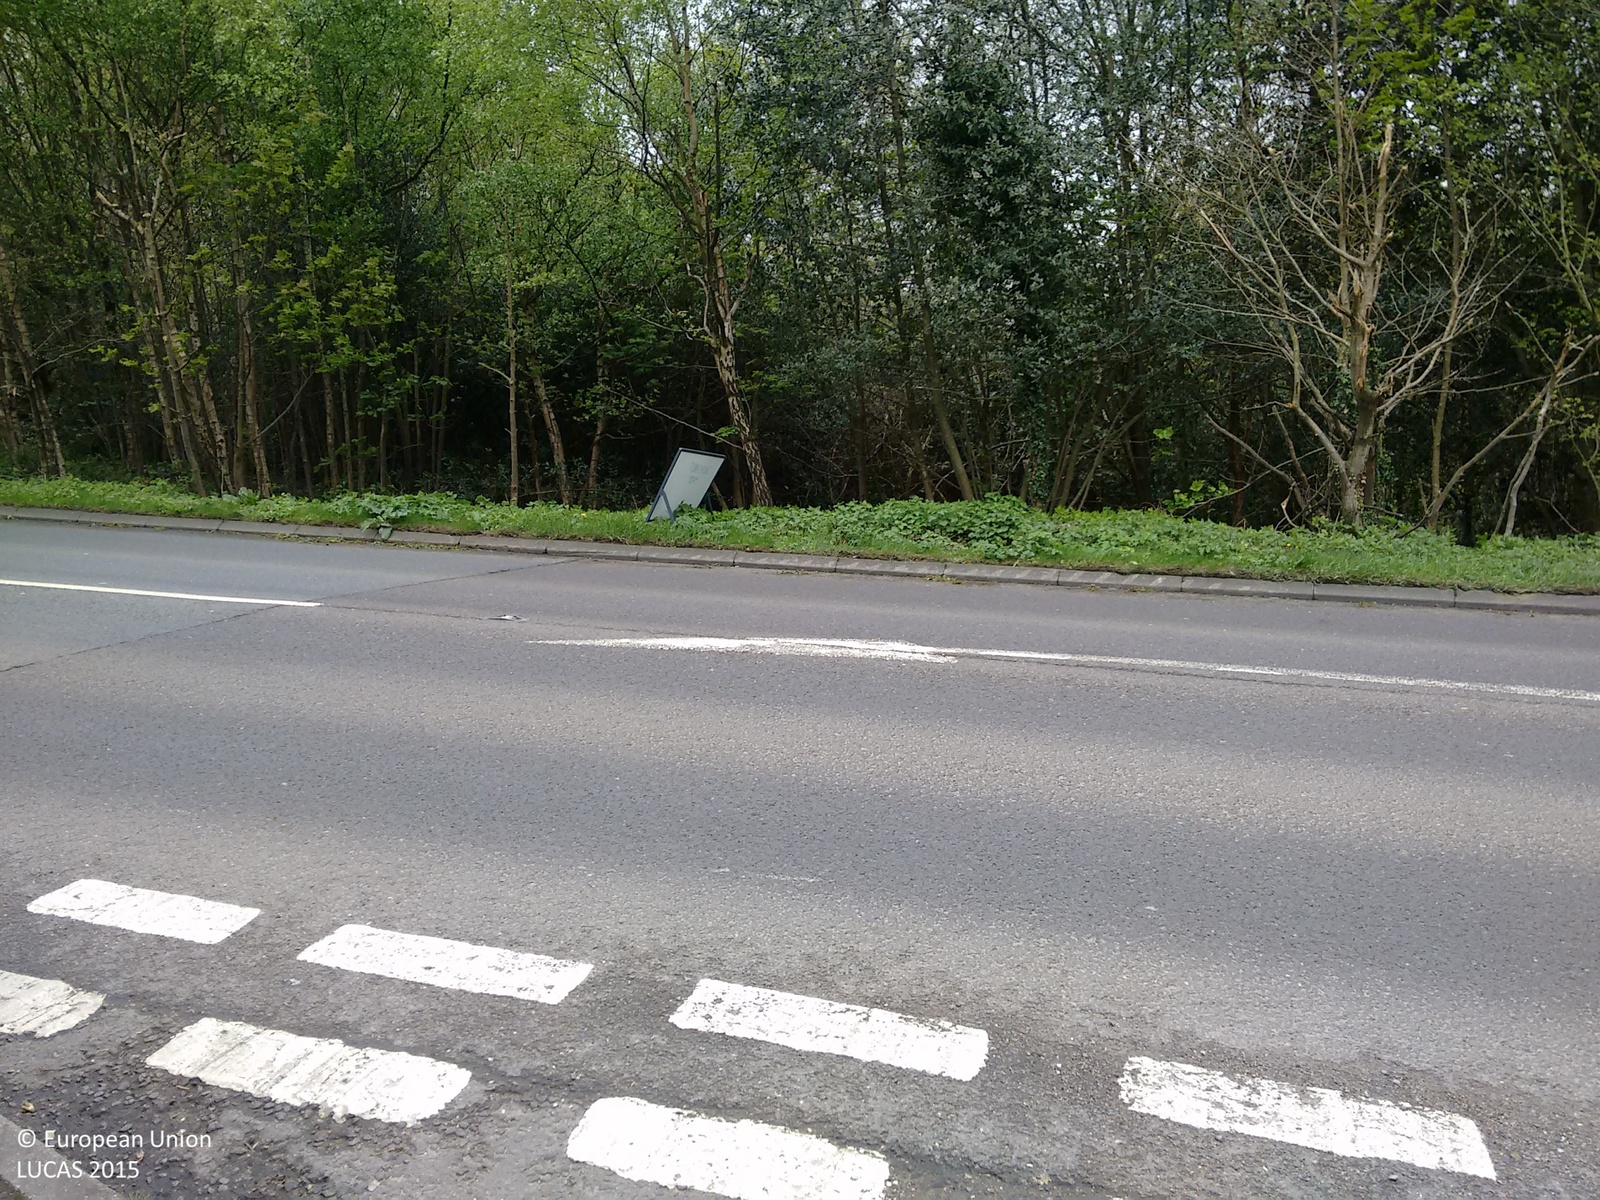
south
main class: Woodland
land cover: Broadleaved woodland
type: mesophytic deciduous forest
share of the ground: > 75 %
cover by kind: broadleaved forest trees 80 %, shrubs 20 %
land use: Forestry
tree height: > 5 m
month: May
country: GB
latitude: 51.2856
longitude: 0.2339
